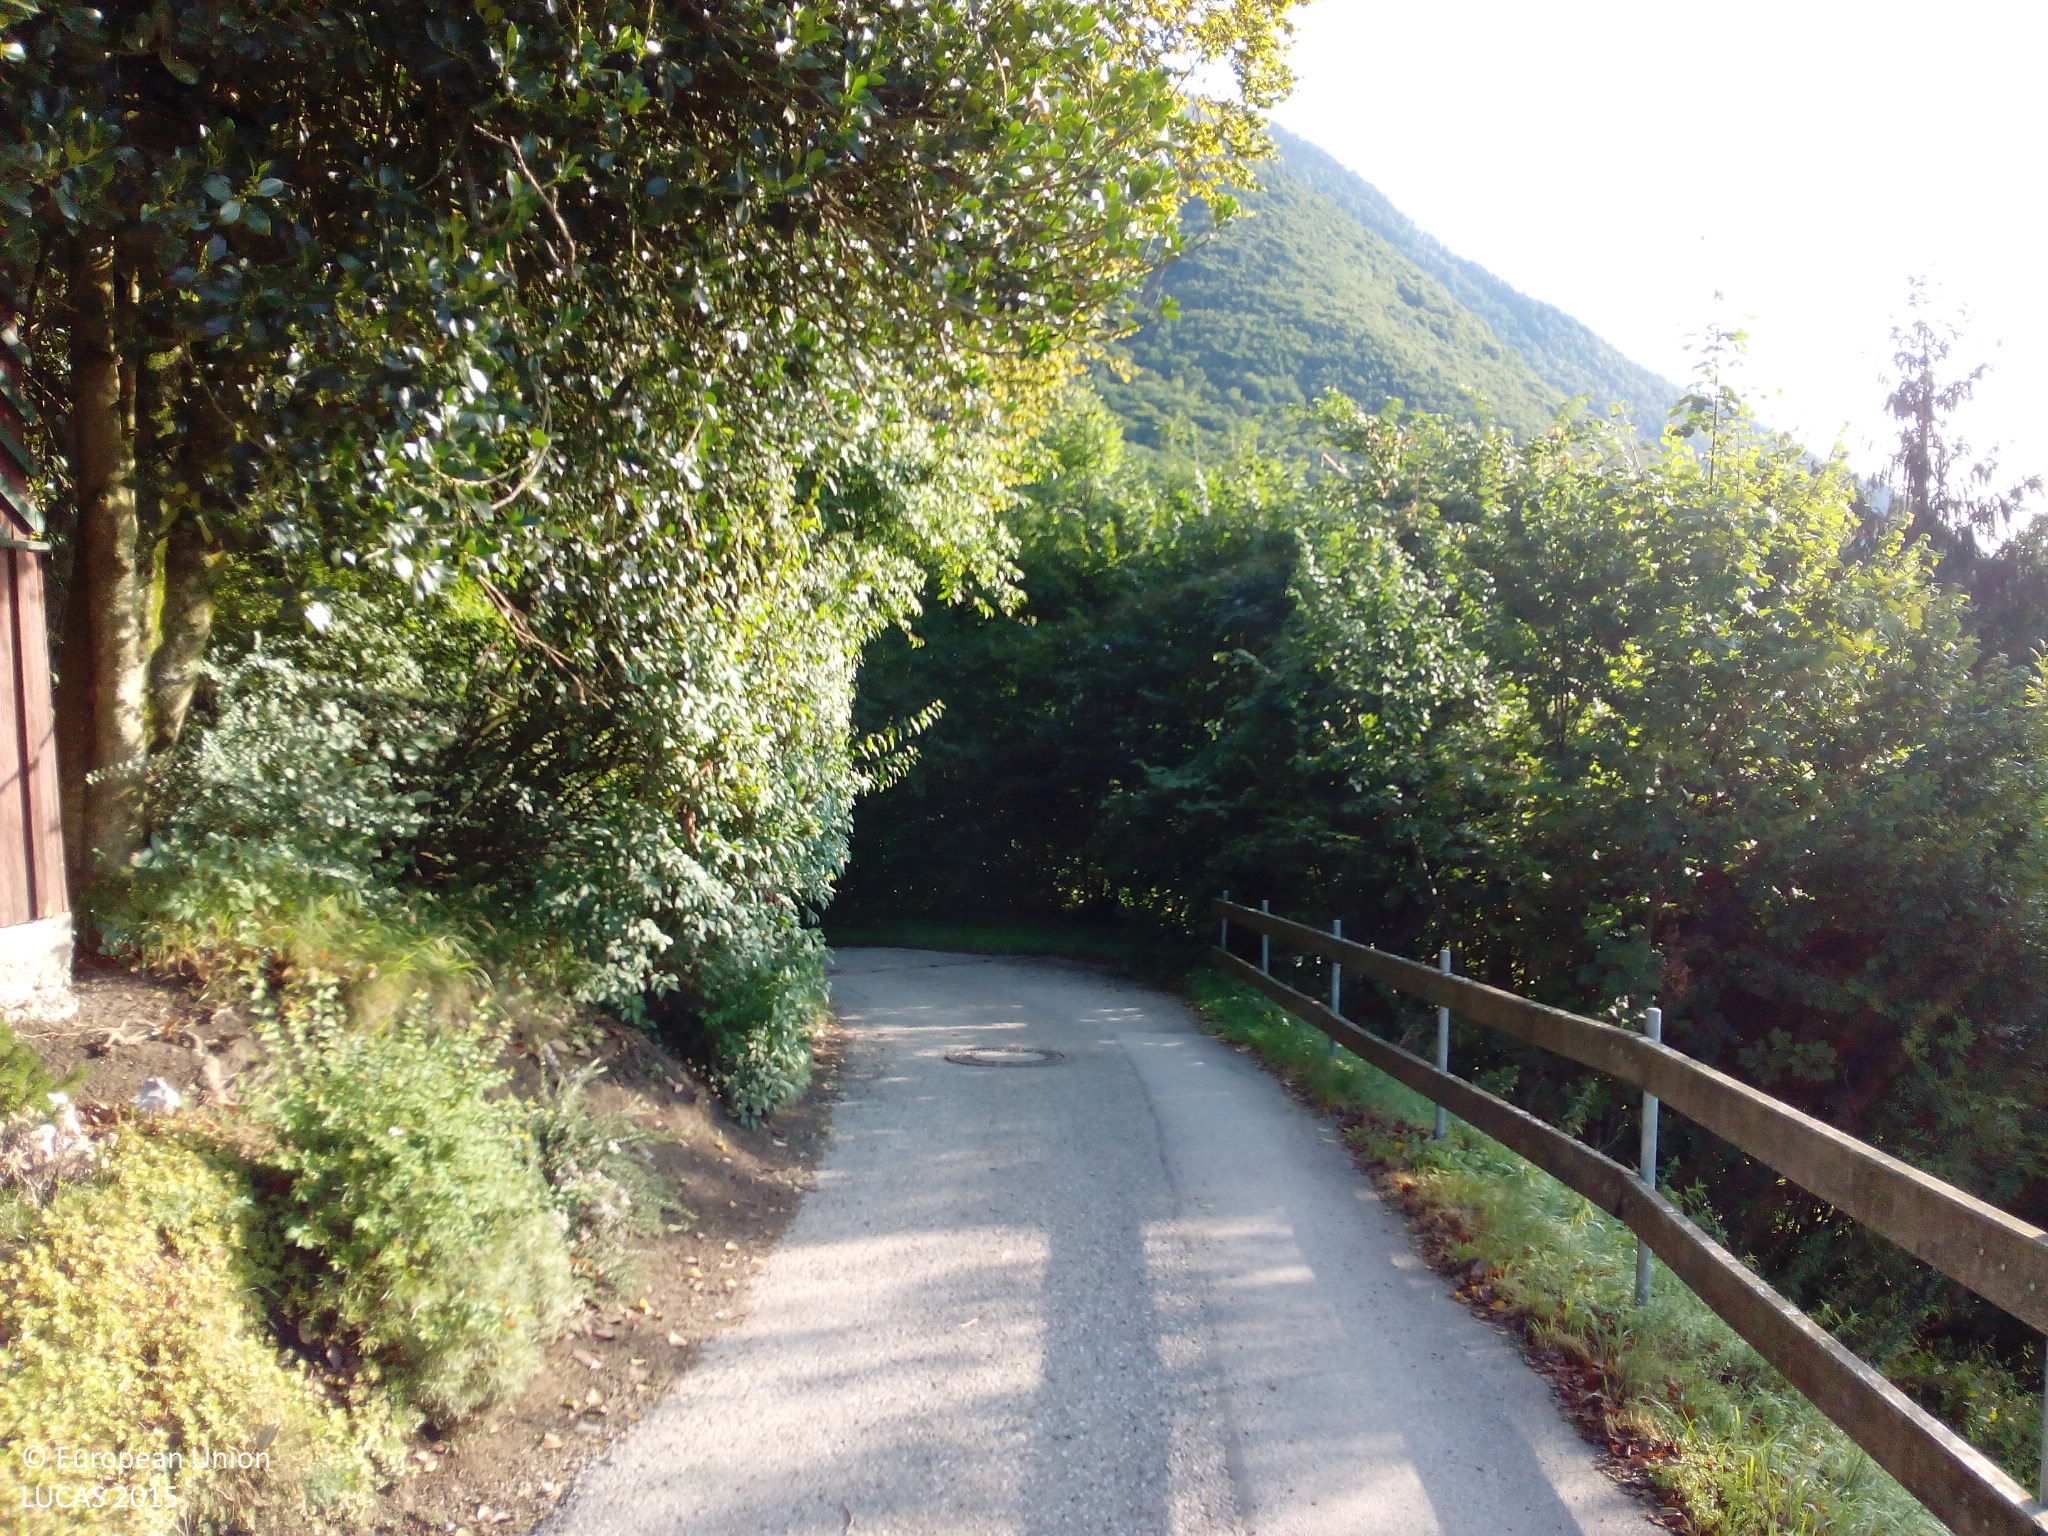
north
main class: Woodland
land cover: Broadleaved woodland
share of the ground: > 75 %
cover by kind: broadleaved forest trees 75 %, herbaceous plants 25 %
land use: Residential
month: August
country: DE
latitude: 47.7361
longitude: 12.8655
